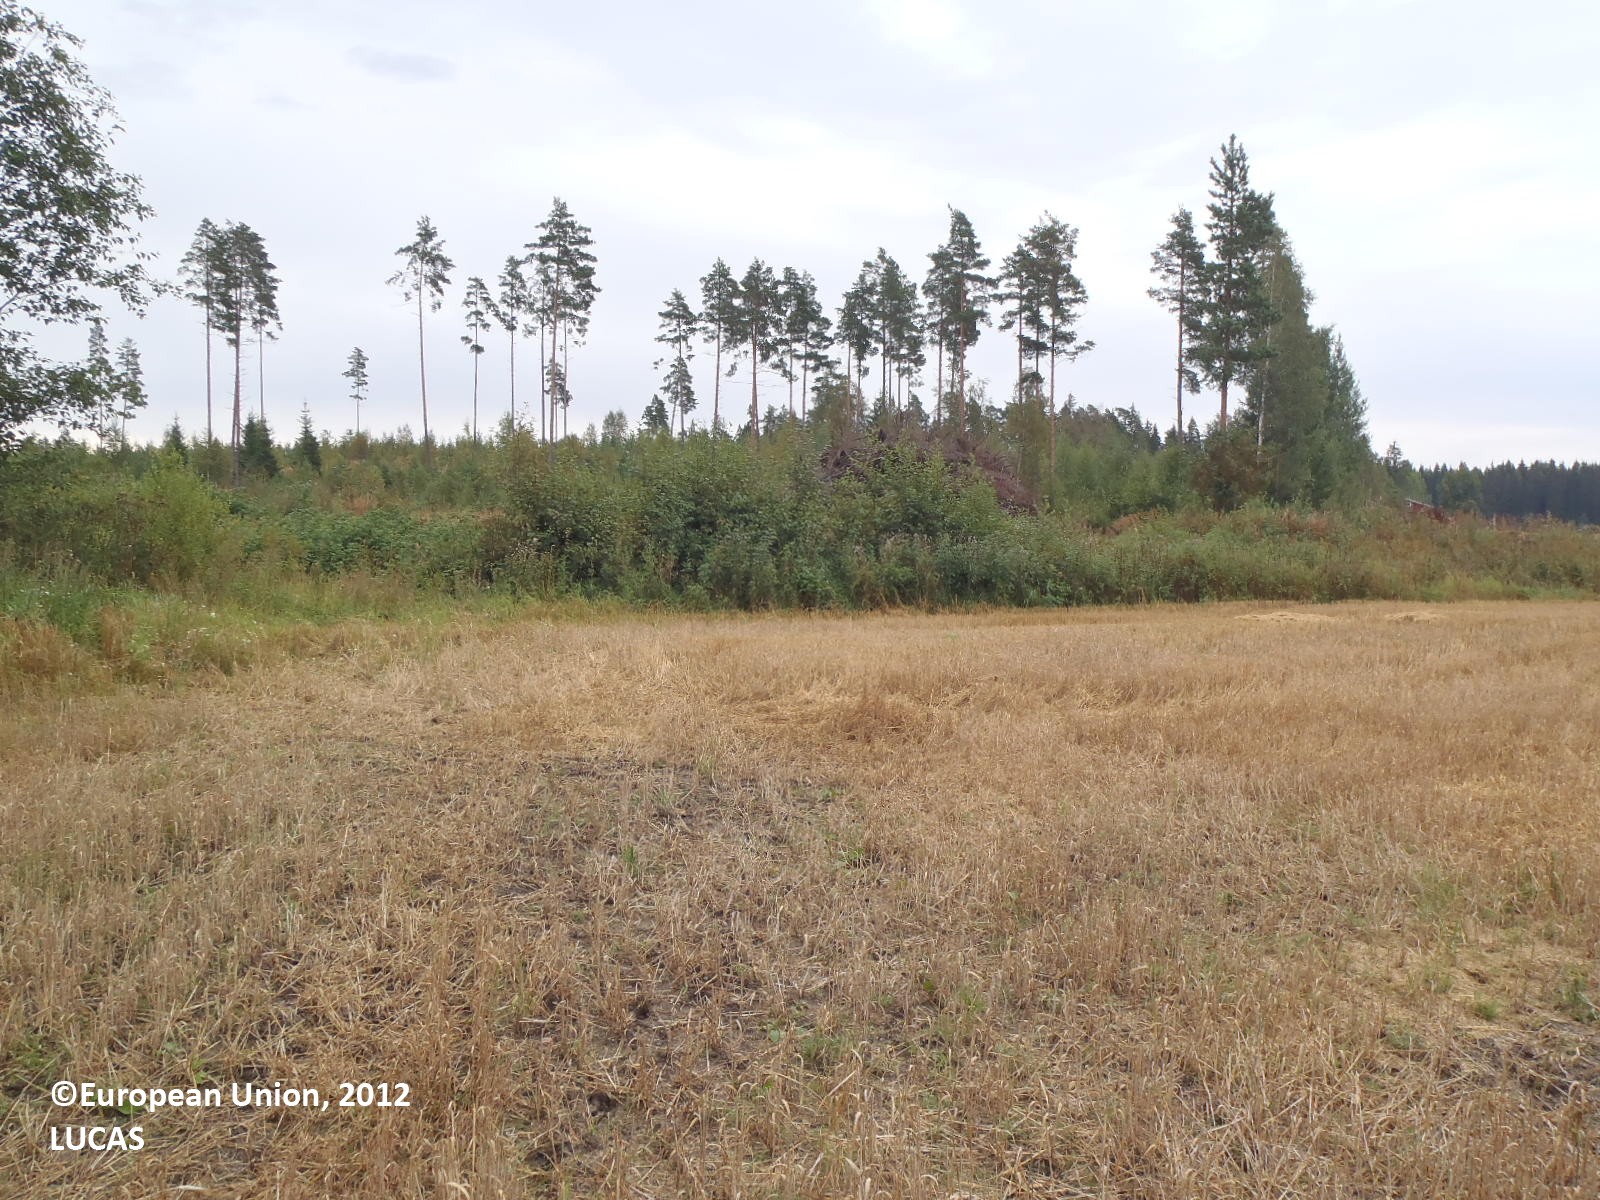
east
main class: Cropland
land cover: Barley
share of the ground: > 75 %
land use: Agriculture (excluding fallow land and kitchen gardens)
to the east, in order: Barley; Abandoned hedges; Ditches and canals; Shrubland without tree cover; Grassland without tree/shrub cover; Ditches and canals; Grassland without tree/shrub cover; Pine dominated mixed woodland
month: August
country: FI
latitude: 60.8754
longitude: 21.9401
